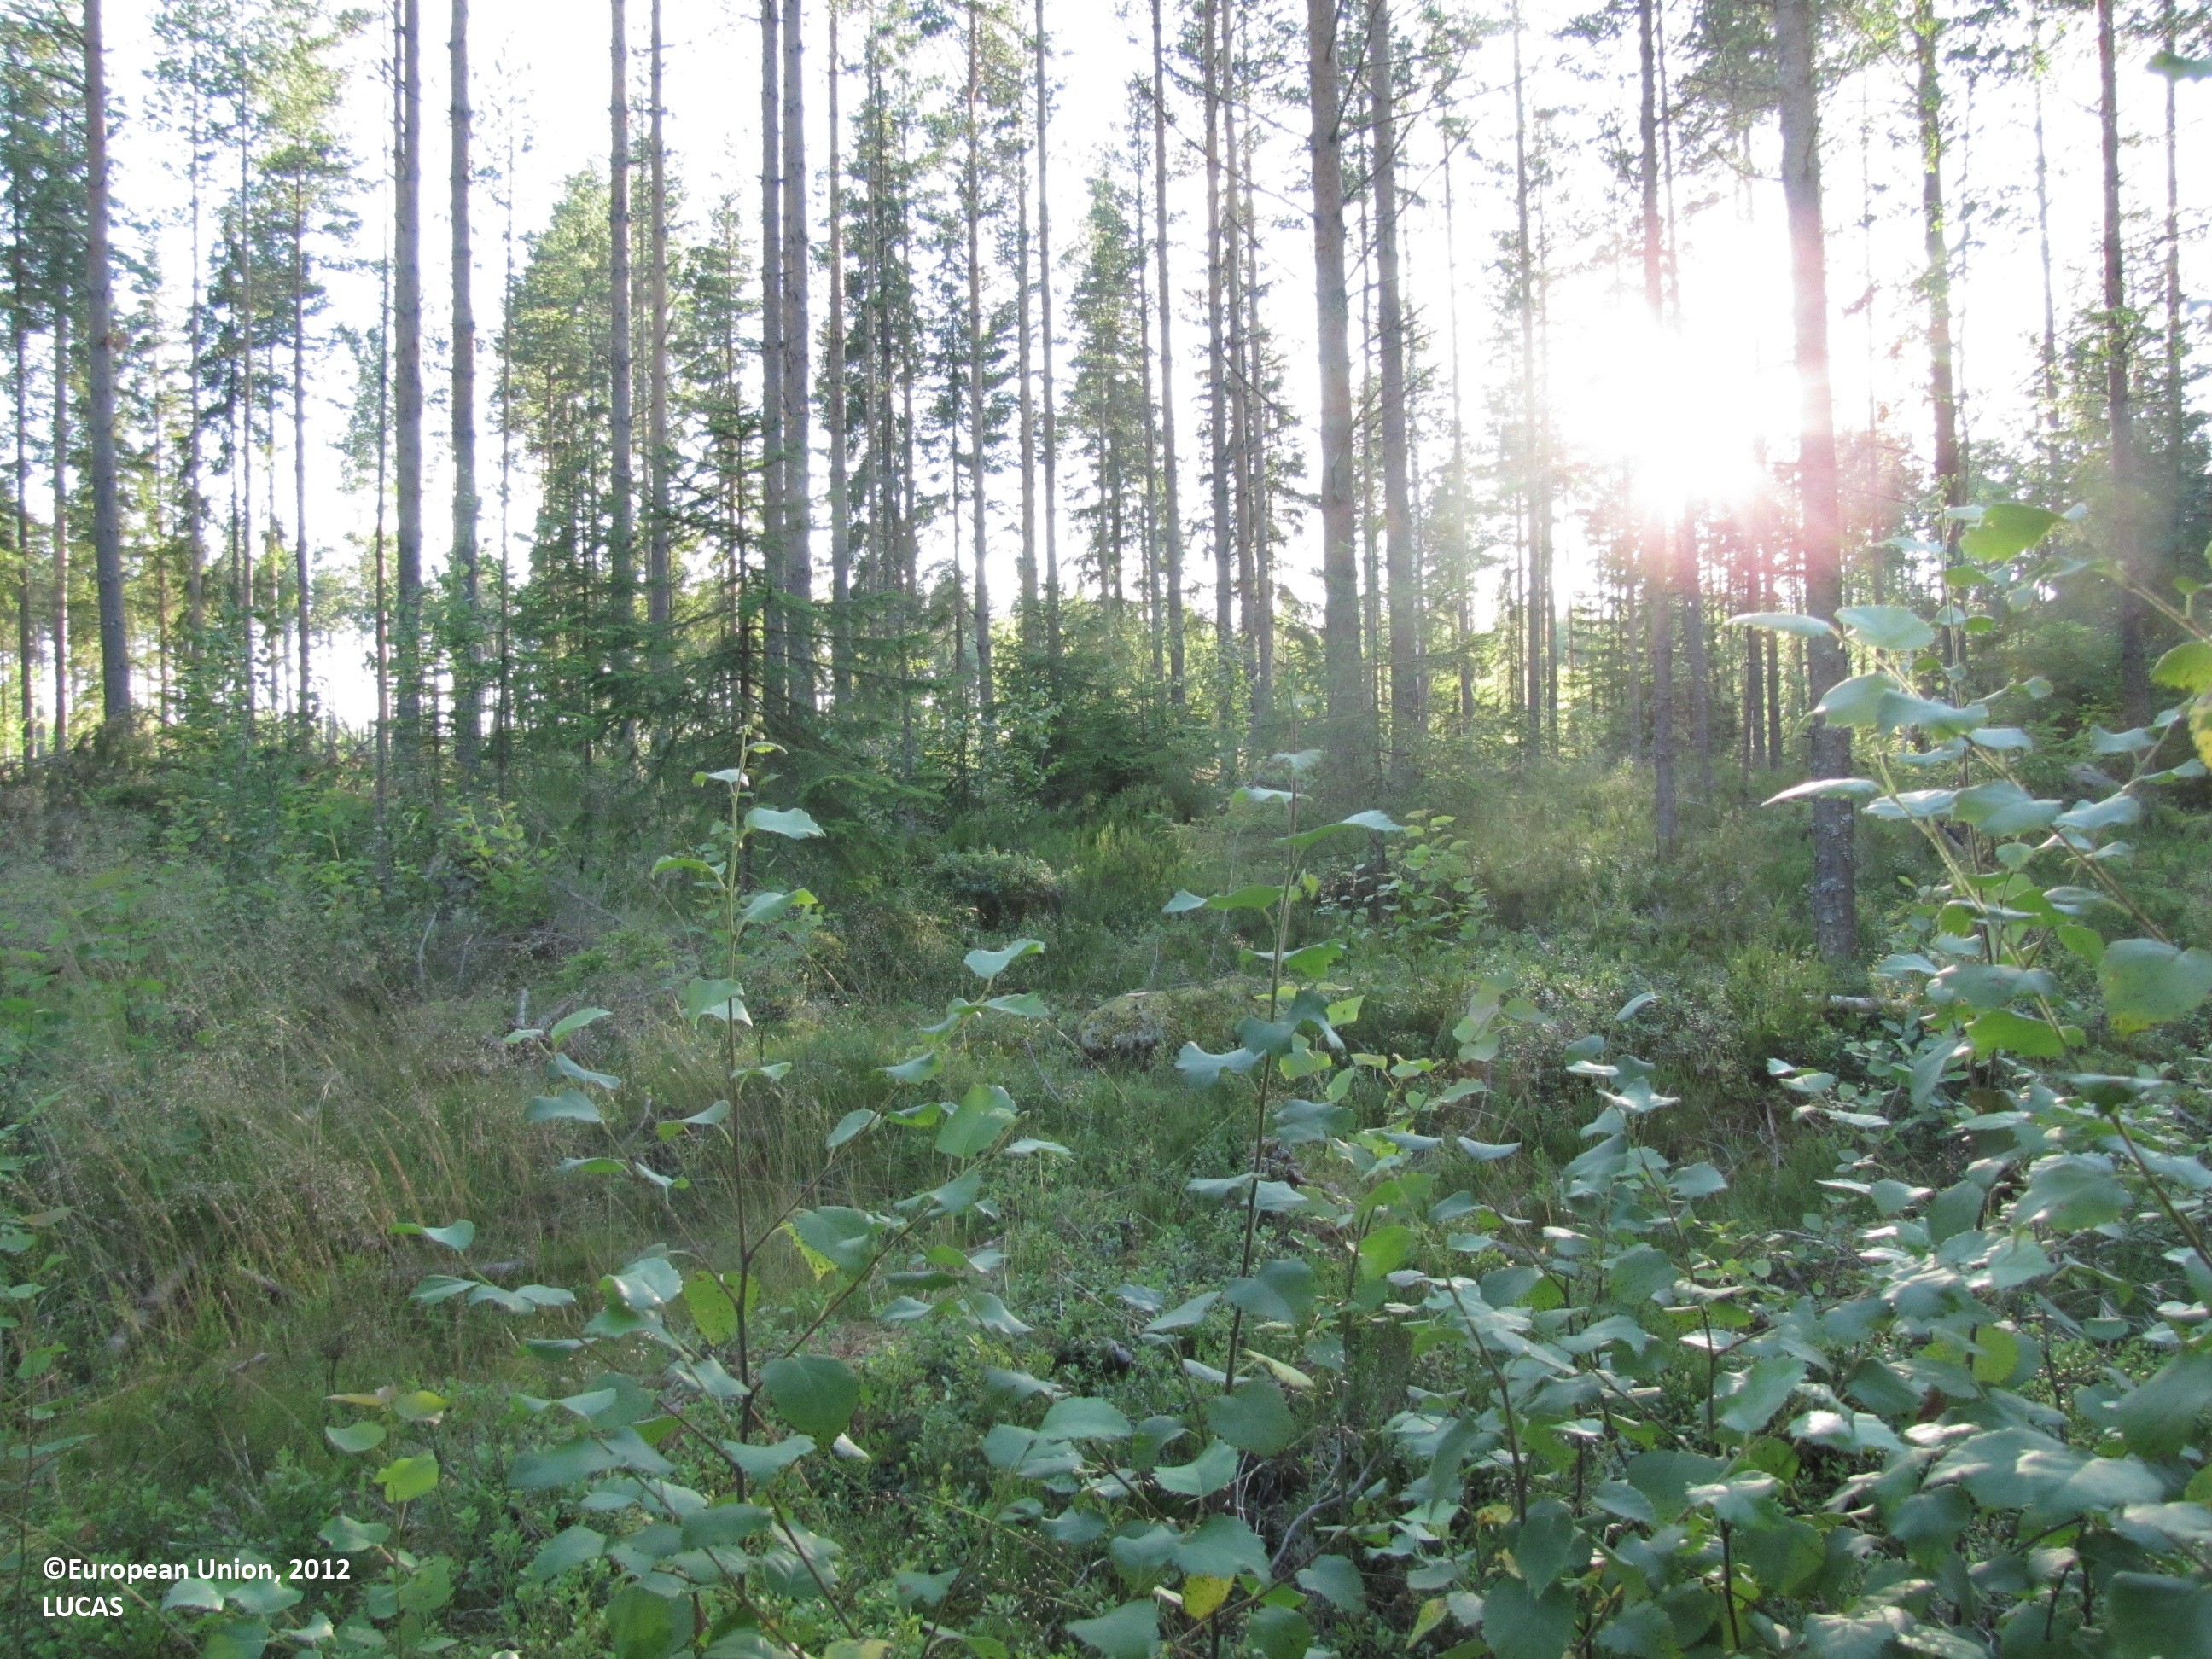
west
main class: Woodland
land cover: Pine dominated coniferous woodland
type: boreal forest
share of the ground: 50 - 75 %
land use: Forestry
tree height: > 5 m
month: July
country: FI
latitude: 62.1219
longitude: 22.9673
